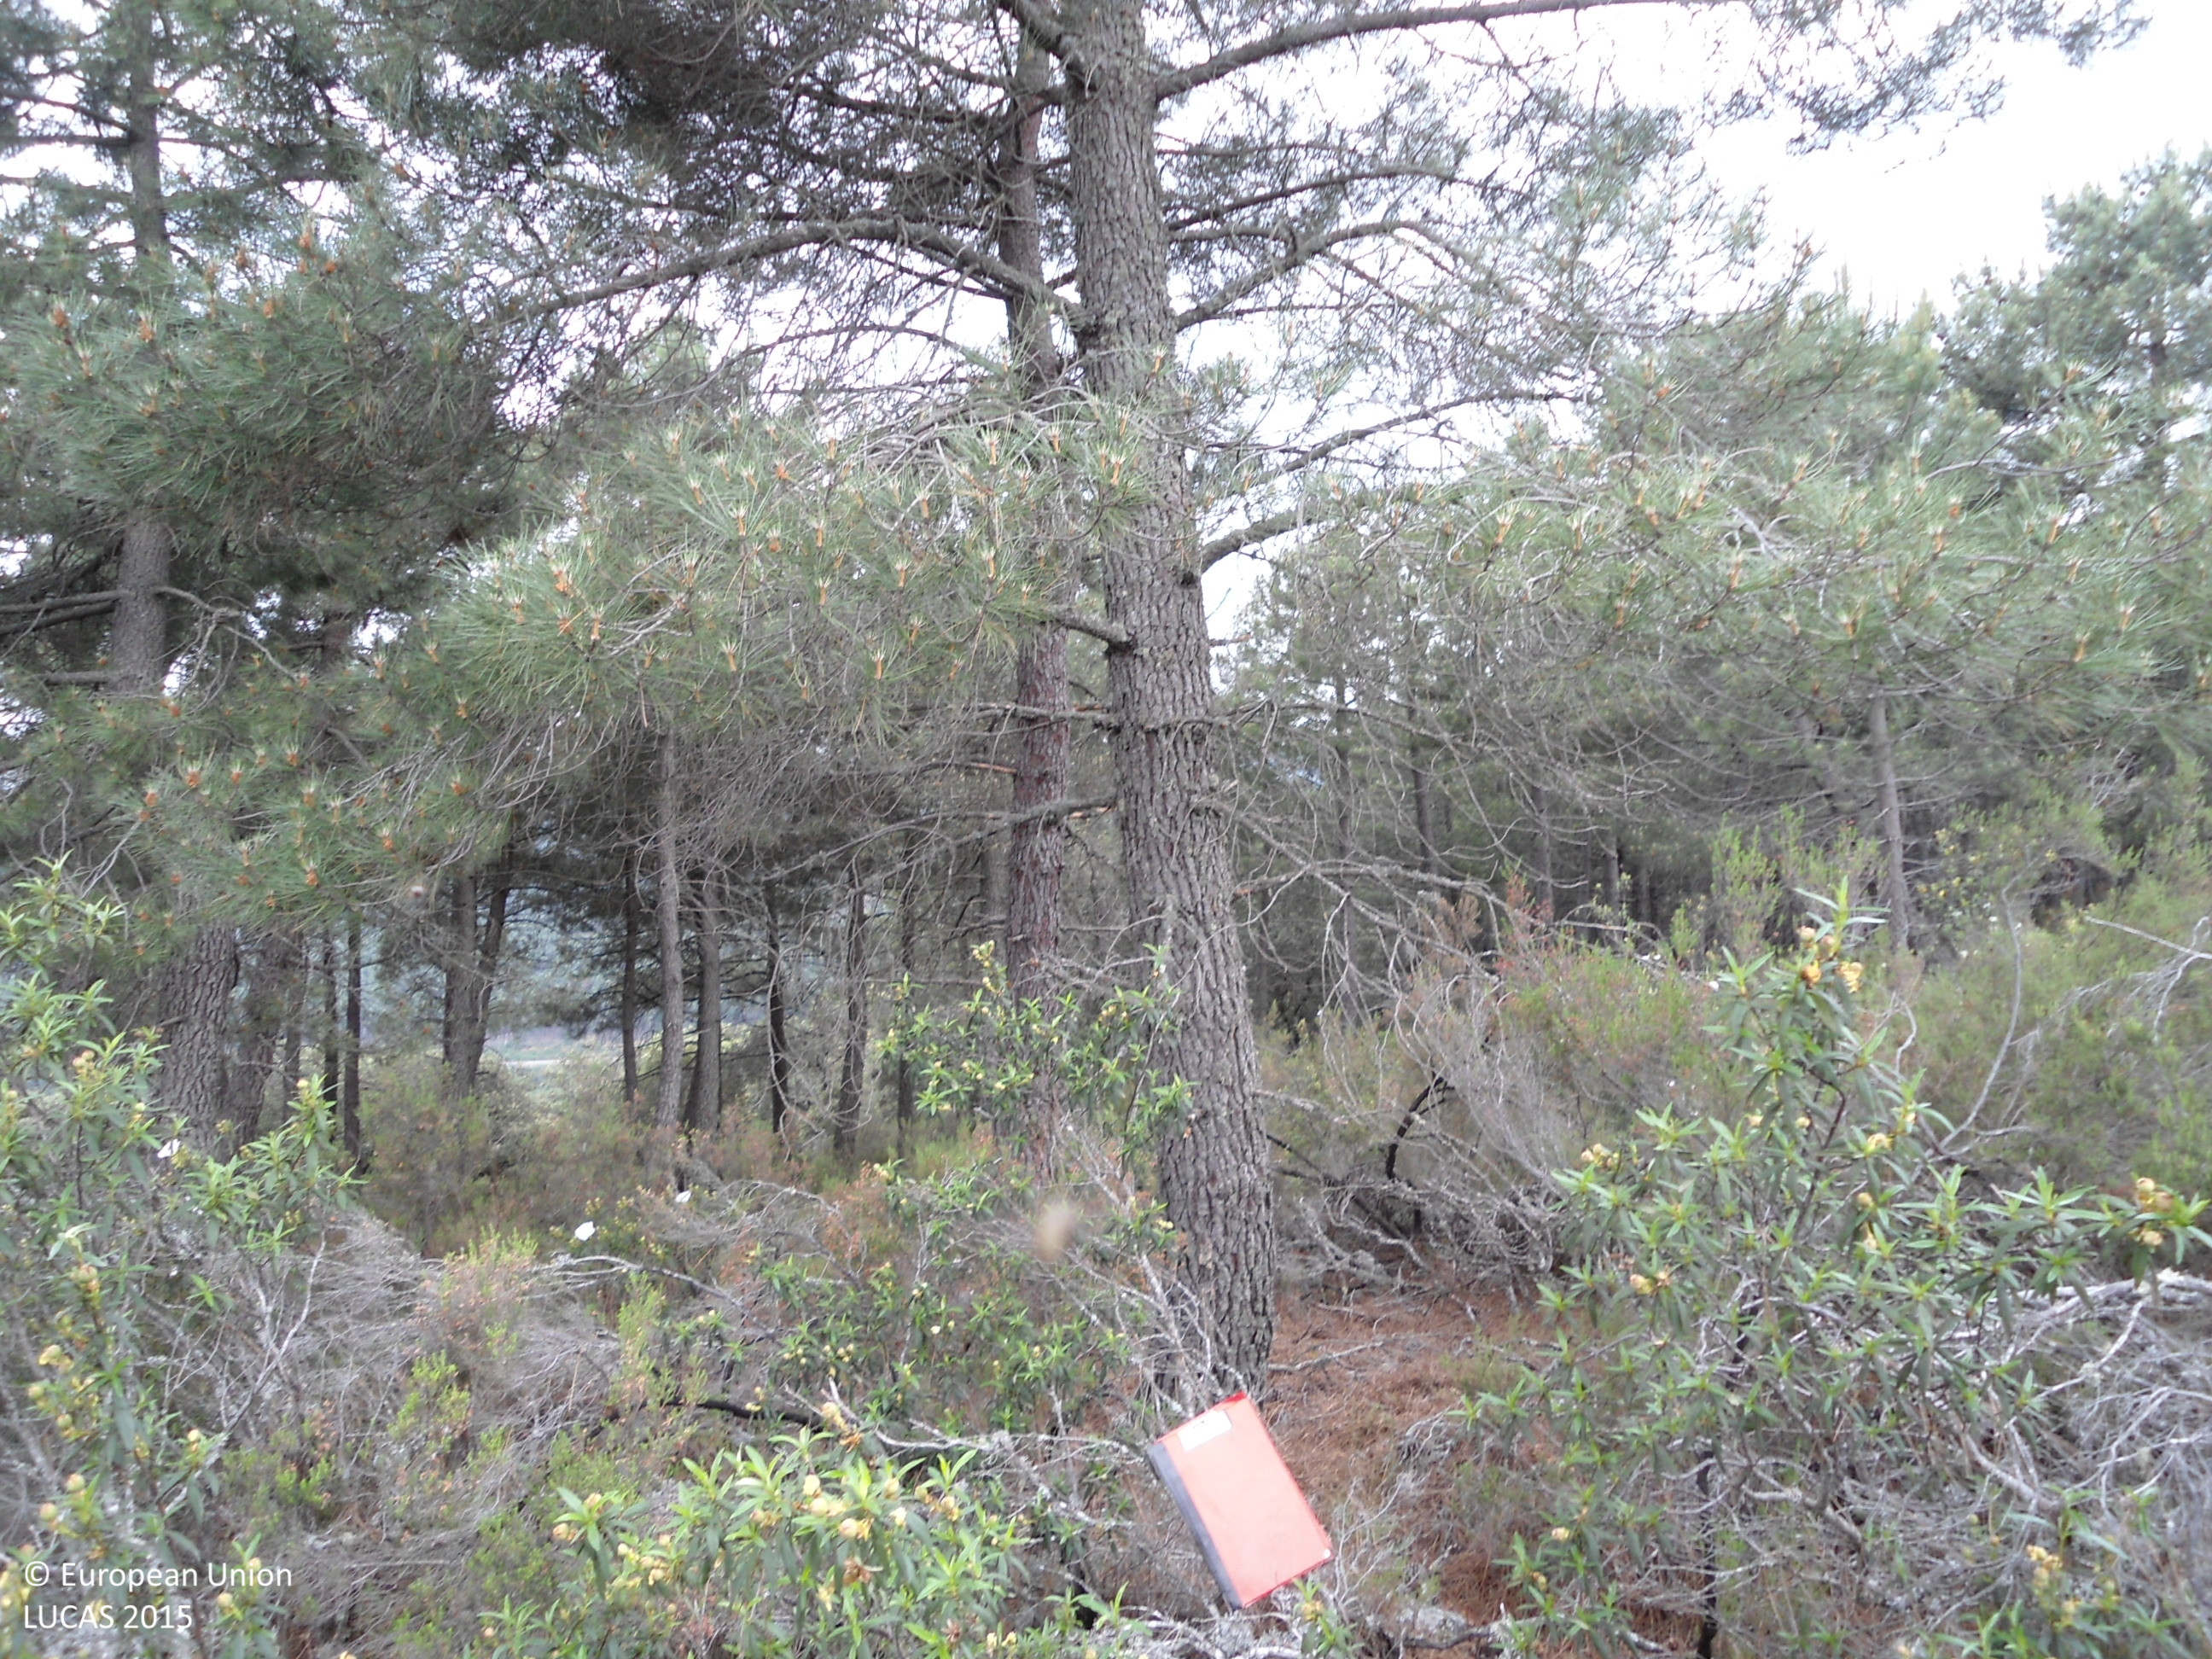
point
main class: Woodland
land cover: Pine dominated mixed woodland
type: coniferous forest of the mediterranean region
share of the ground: > 75 %
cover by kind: coniferous forest trees 65 %, broadleaved forest trees 25 %, shrubs 10 %
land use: Forestry
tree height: > 5 m
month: June
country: ES
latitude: 41.8751
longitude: -6.1867
